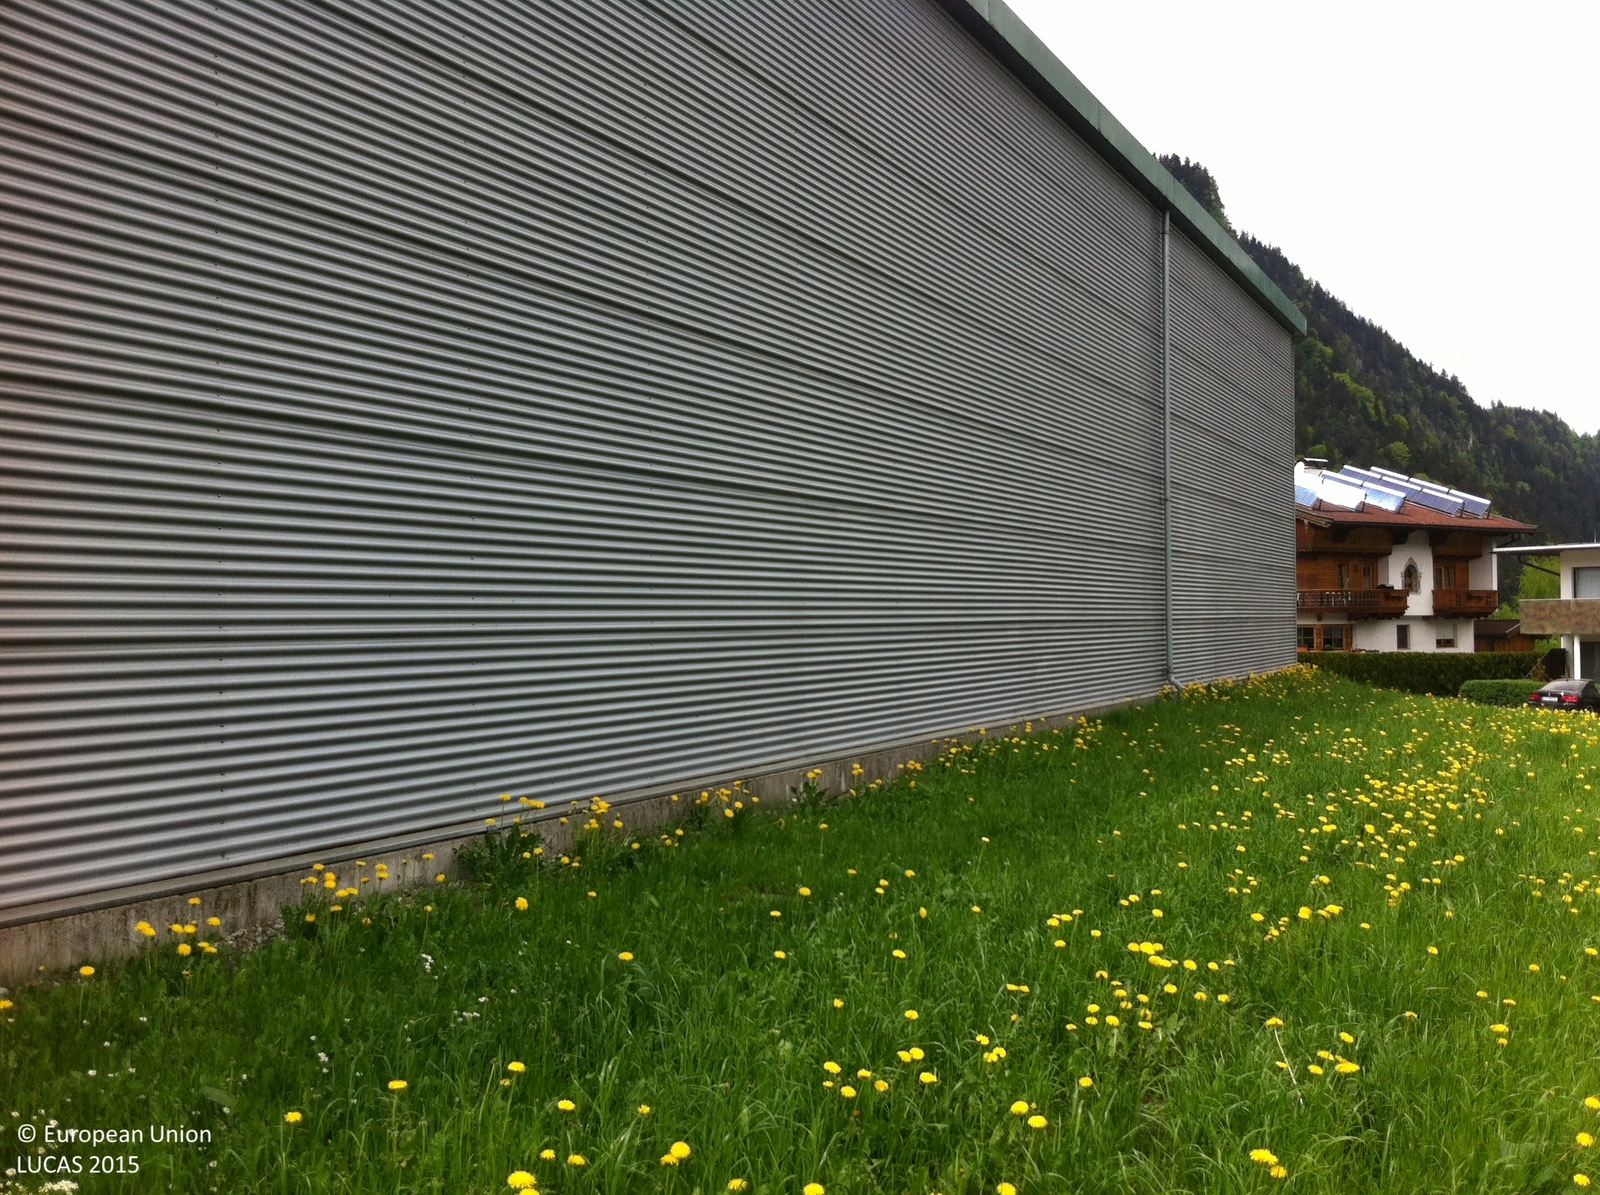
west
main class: Grassland
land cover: Grassland without tree/shrub cover
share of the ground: > 75 %
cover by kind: herbaceous plants 100 %
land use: Agriculture (excluding fallow land and kitchen gardens)
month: May
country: AT
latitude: 47.3801
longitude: 11.8396
